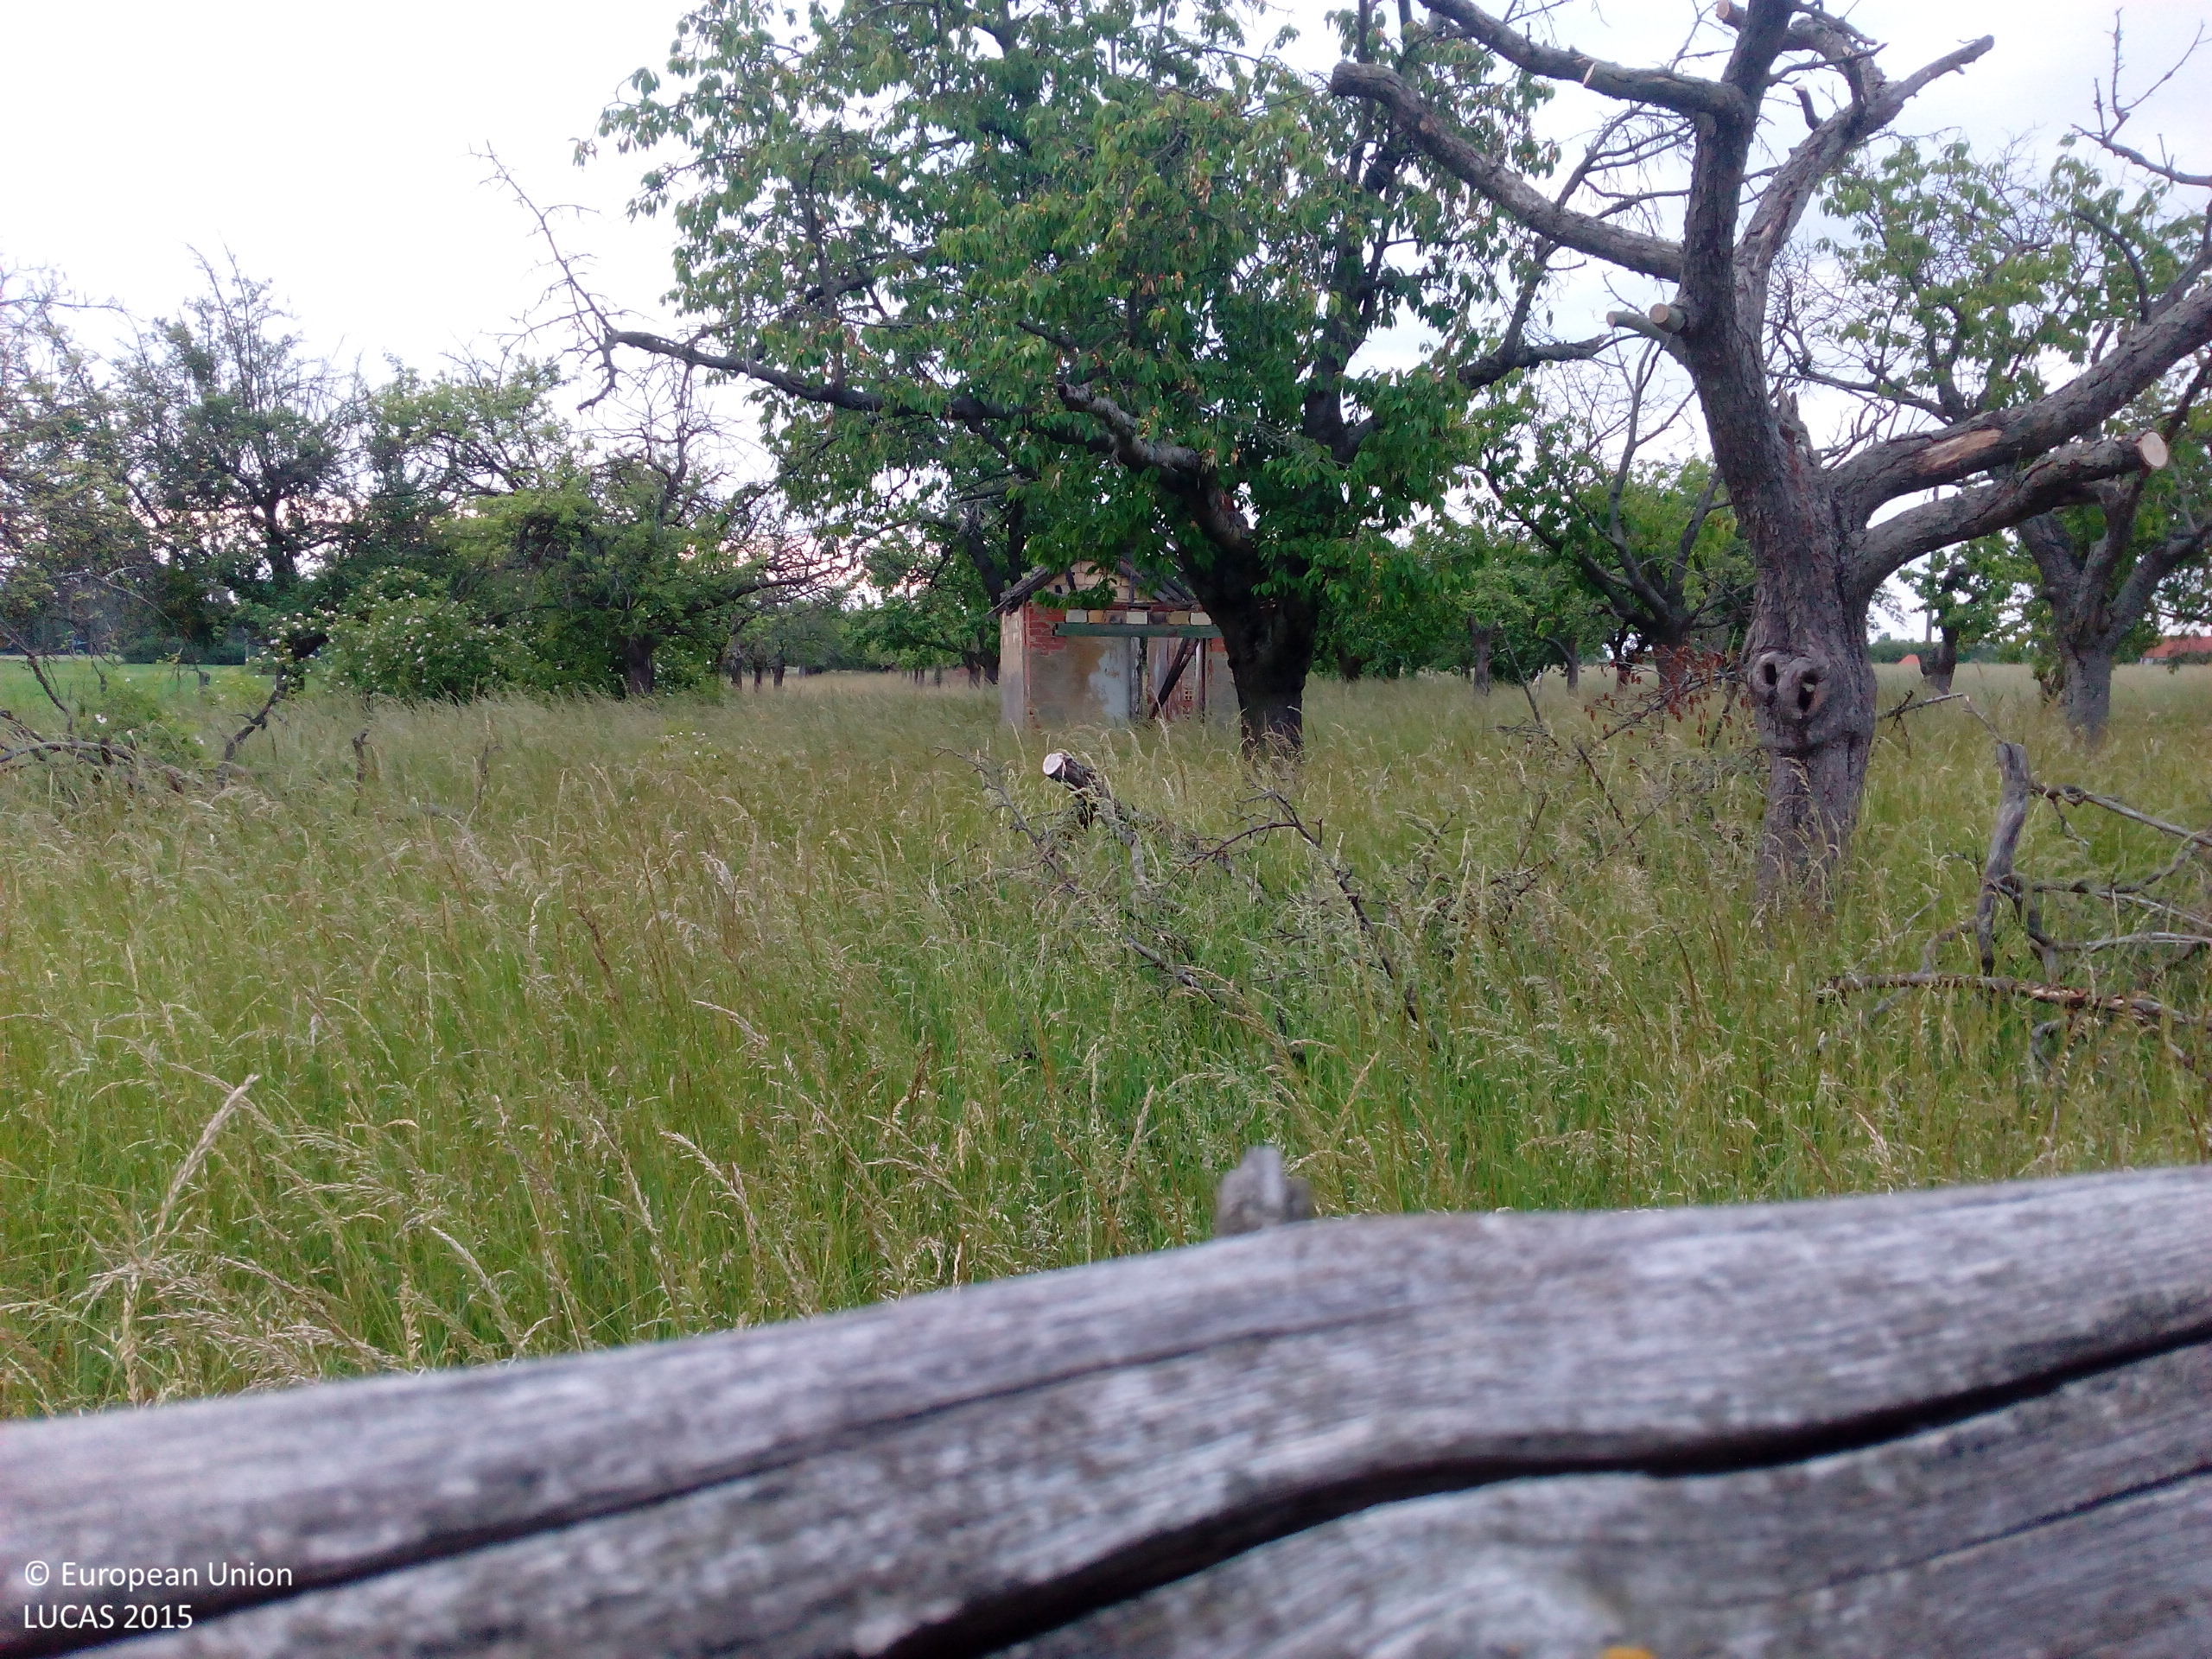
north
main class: Cropland
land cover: Apple fruit
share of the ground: 50 - 75 %
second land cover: Grassland without tree/shrub cover
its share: > 75 %
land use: Abandoned areas
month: June
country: DE
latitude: 51.6870
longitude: 12.4443
